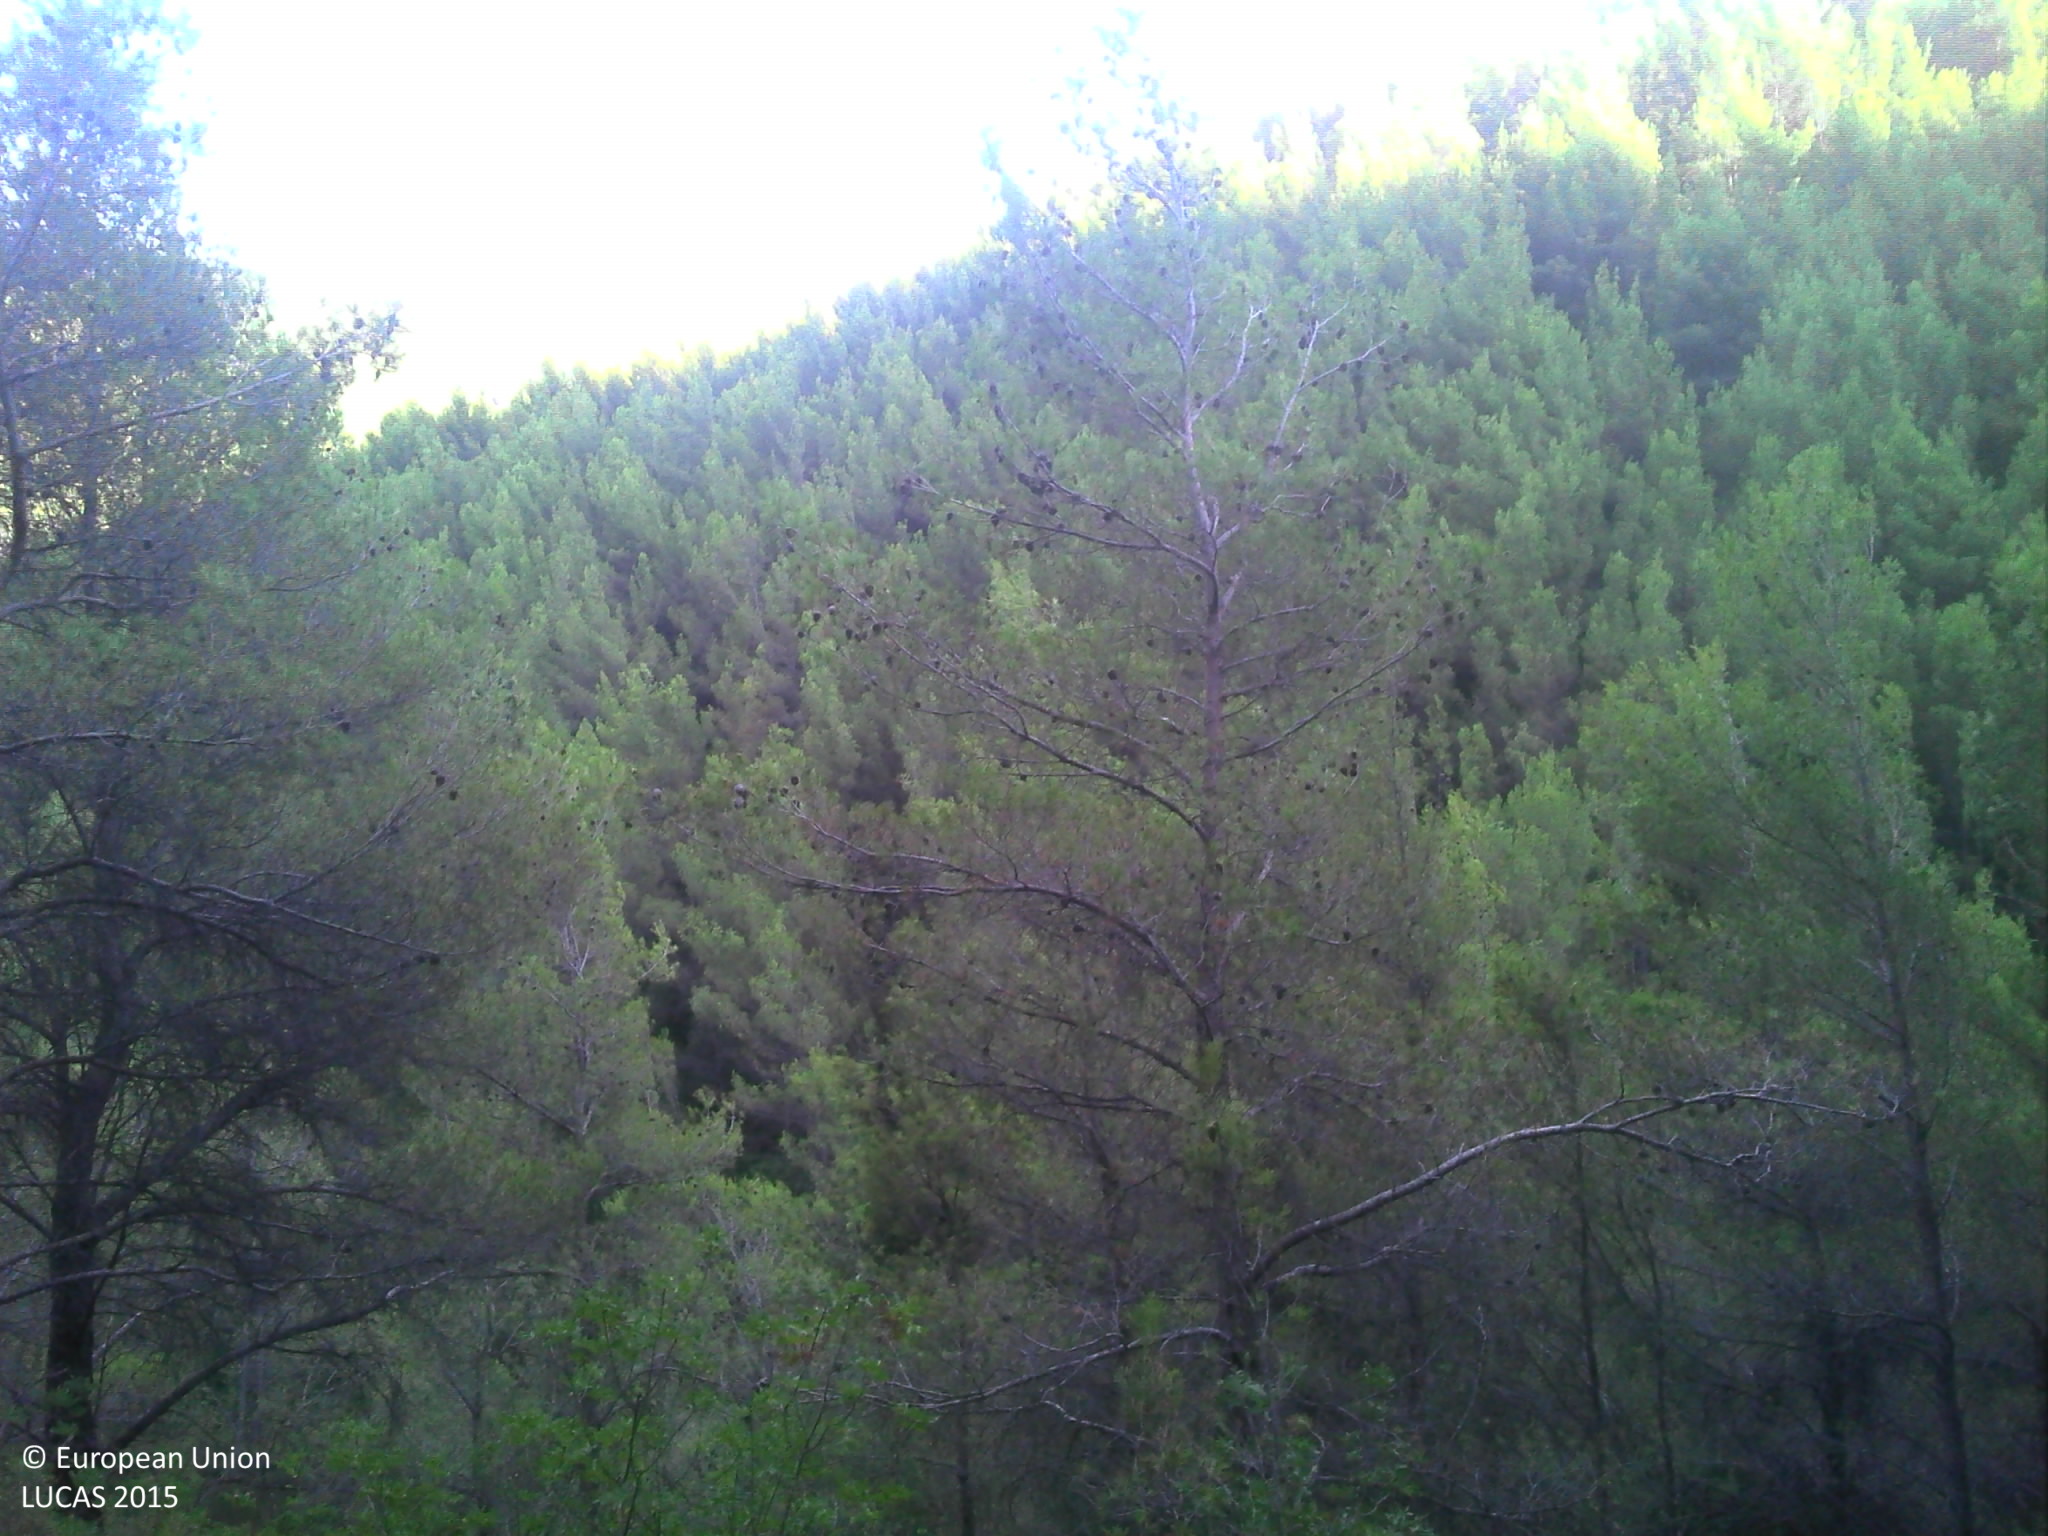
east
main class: Woodland
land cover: Pine dominated coniferous woodland
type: coniferous forest of the mediterranean region
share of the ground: > 75 %
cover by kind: coniferous forest trees 60 %, shrubs 20 %, unconsolidated bare surface 15 %, herbaceous plants 5 %
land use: Forestry
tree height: > 5 m
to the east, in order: Pine dominated coniferous woodland; Rocks and stones; Pine dominated coniferous woodland; Rivers and streams; Pine dominated mixed woodland; Broadleaved woodland; Tracks; Broadleaved woodland; Rock outcrops; Broadleaved woodland
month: August
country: FR
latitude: 43.3563
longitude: 5.6546
